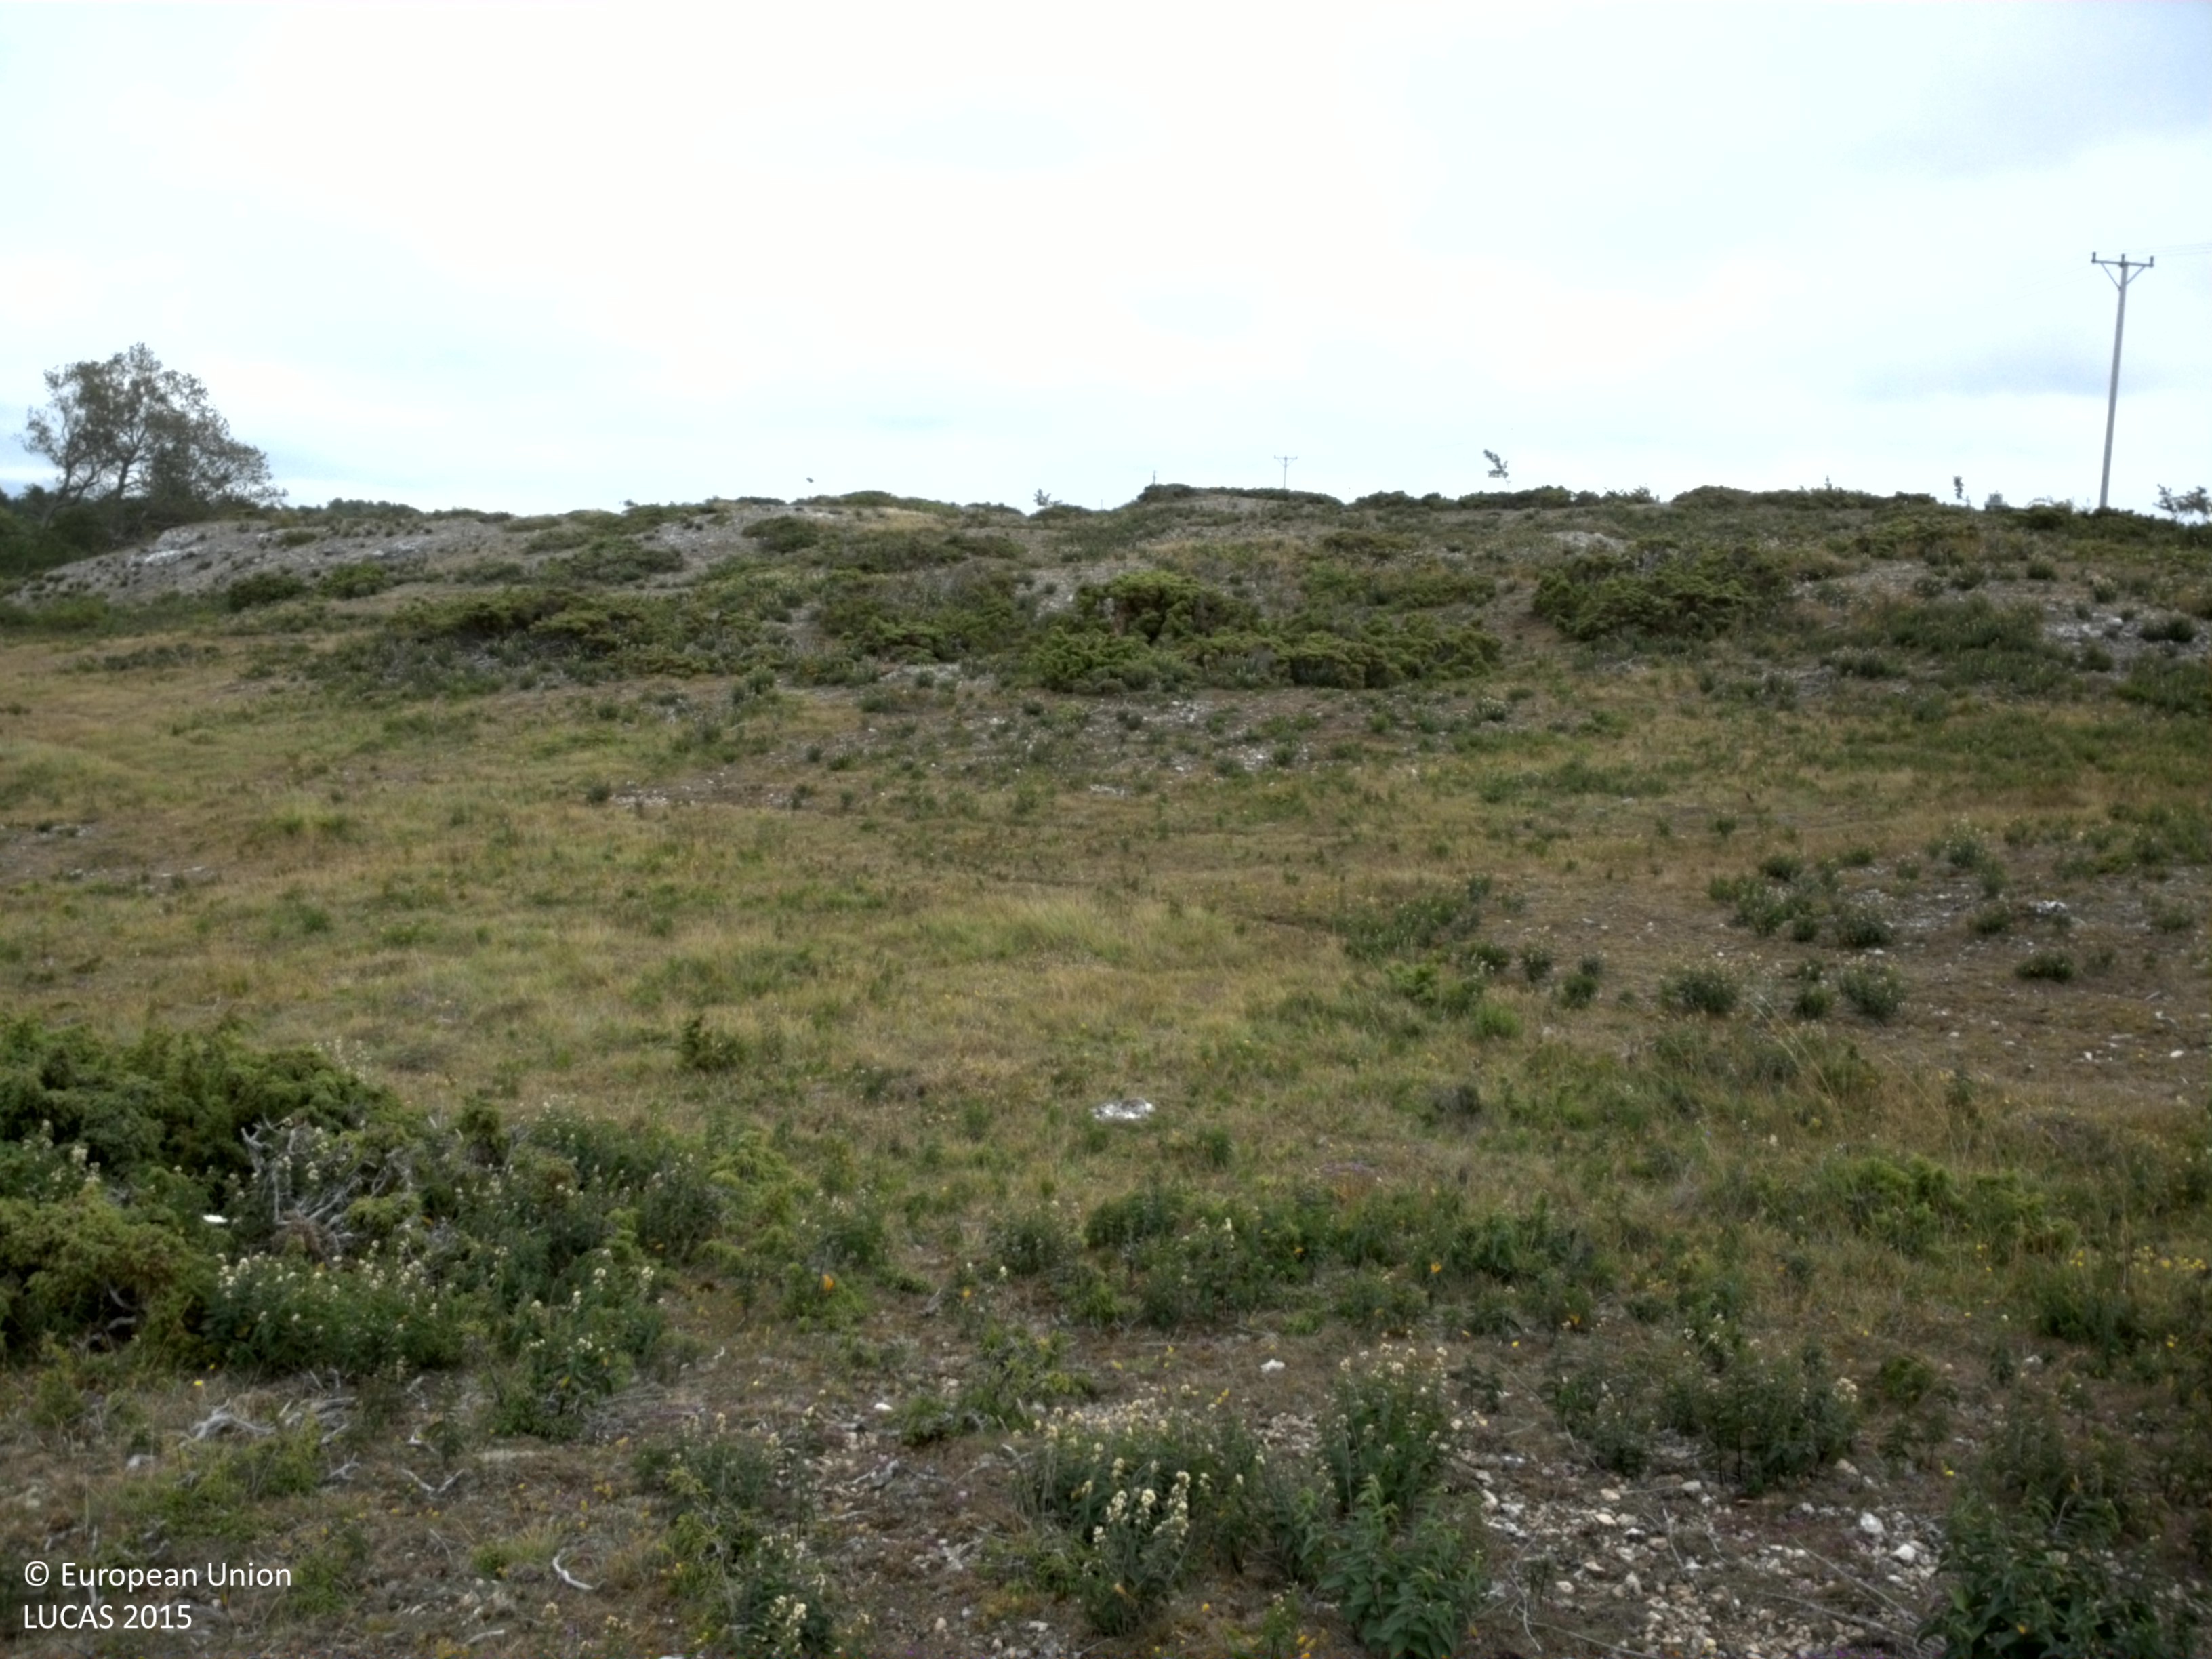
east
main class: Shrubland
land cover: Shrubland without tree cover
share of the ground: 50 - 75 %
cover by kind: shrubs 55 %, herbaceous plants 25 %, lichens and mosses 10 %, unconsolidated bare surface 10 %
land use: Agriculture (excluding fallow land and kitchen gardens)
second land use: Amenities, museums, leisure
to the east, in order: Shrubland without tree cover; Electric lines; Shrubland without tree cover; Tracks; Shrubland without tree cover
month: July
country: SE
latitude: 56.9234
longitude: 18.1407
